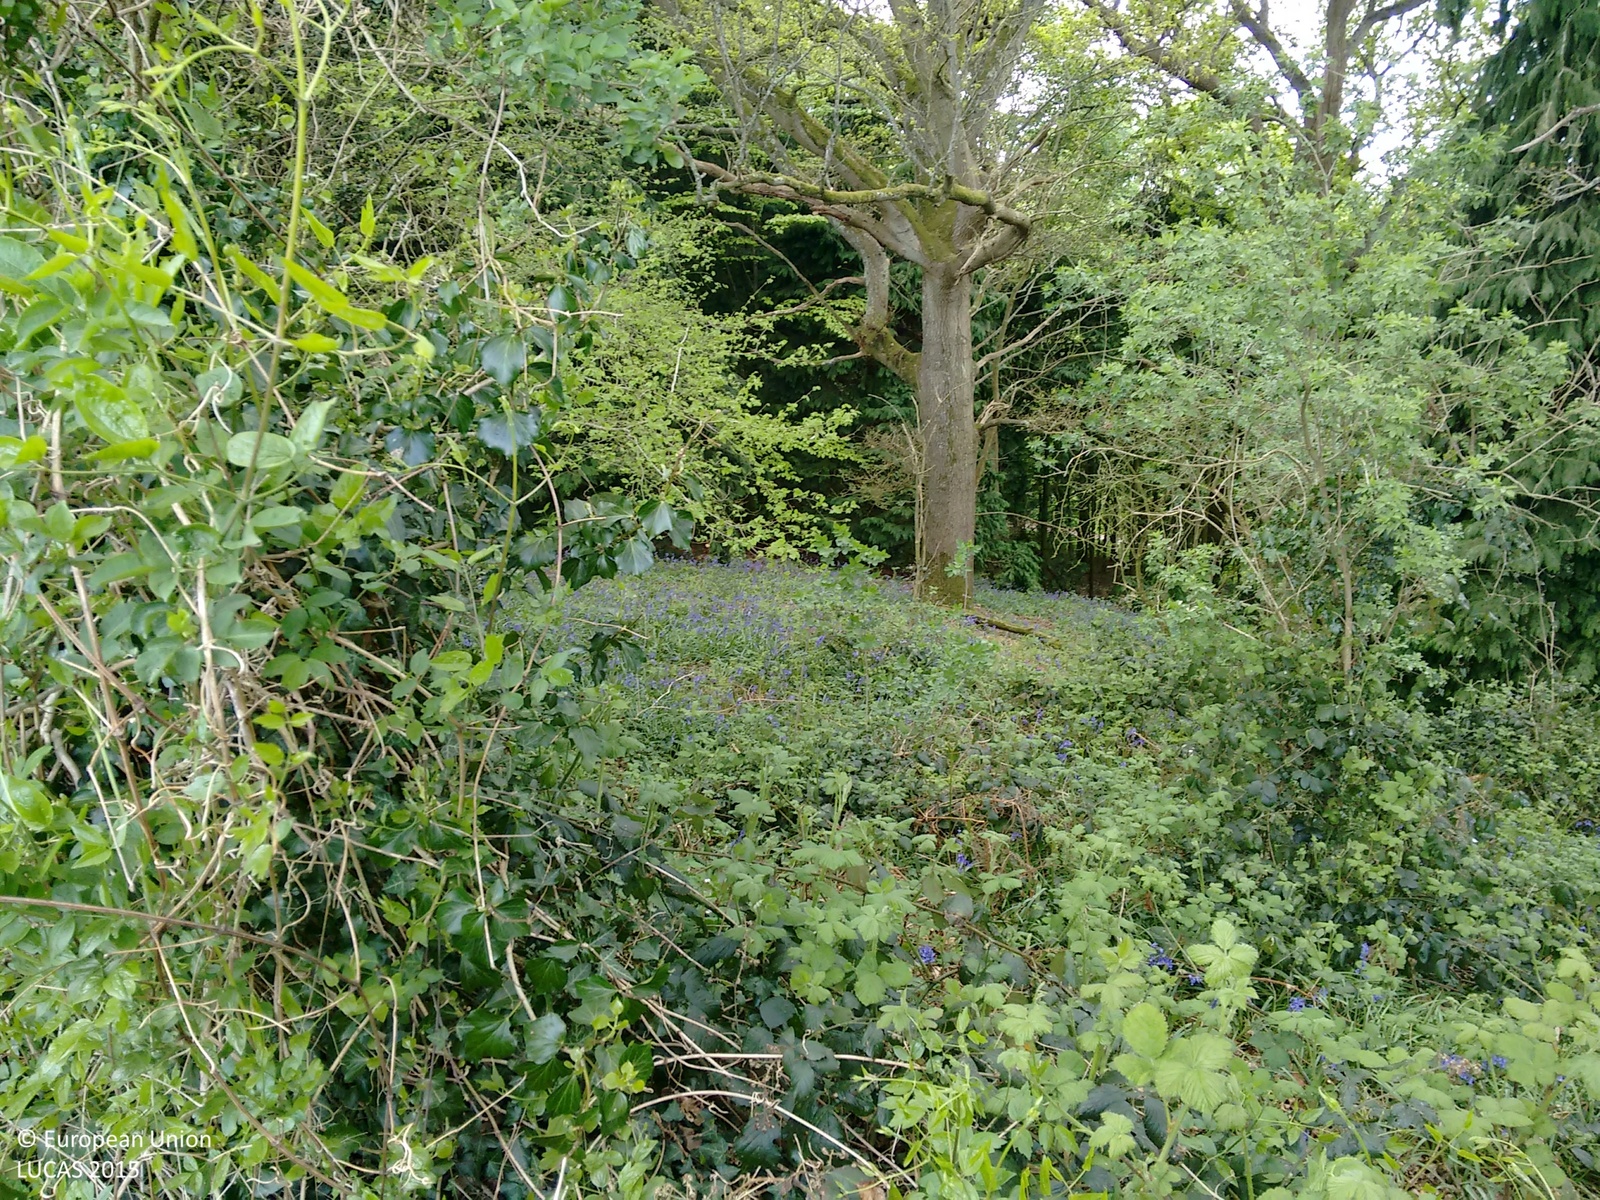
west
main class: Woodland
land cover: Broadleaved woodland
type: mesophytic deciduous forest
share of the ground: > 75 %
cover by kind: broadleaved forest trees 100 %
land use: Semi-natural and natural areas not in use
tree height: > 5 m
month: April
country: GB
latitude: 50.9653
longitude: -1.8315
